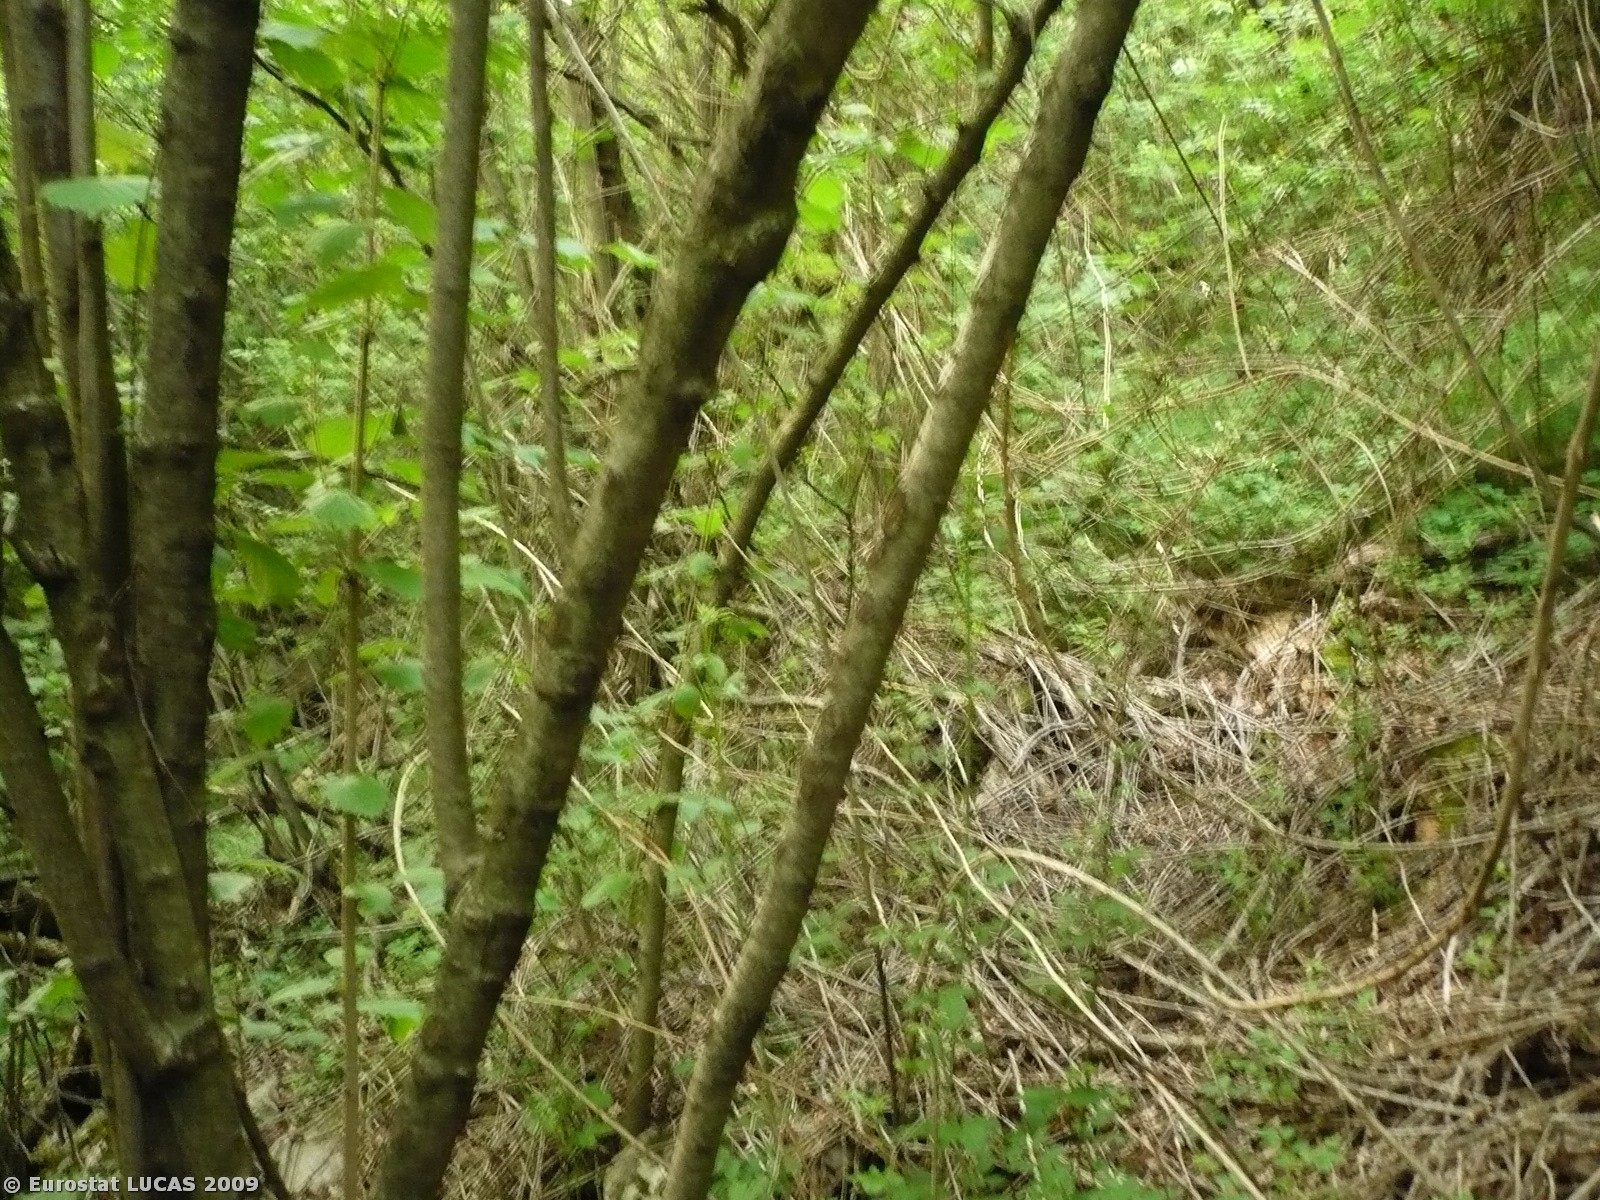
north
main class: Woodland
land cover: Broadleaved woodland
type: thermophilous deciduous forest
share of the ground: > 75 %
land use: Agriculture (excluding fallow land and kitchen gardens)
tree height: > 5 m
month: May
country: SI
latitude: 46.0535
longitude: 13.6799
